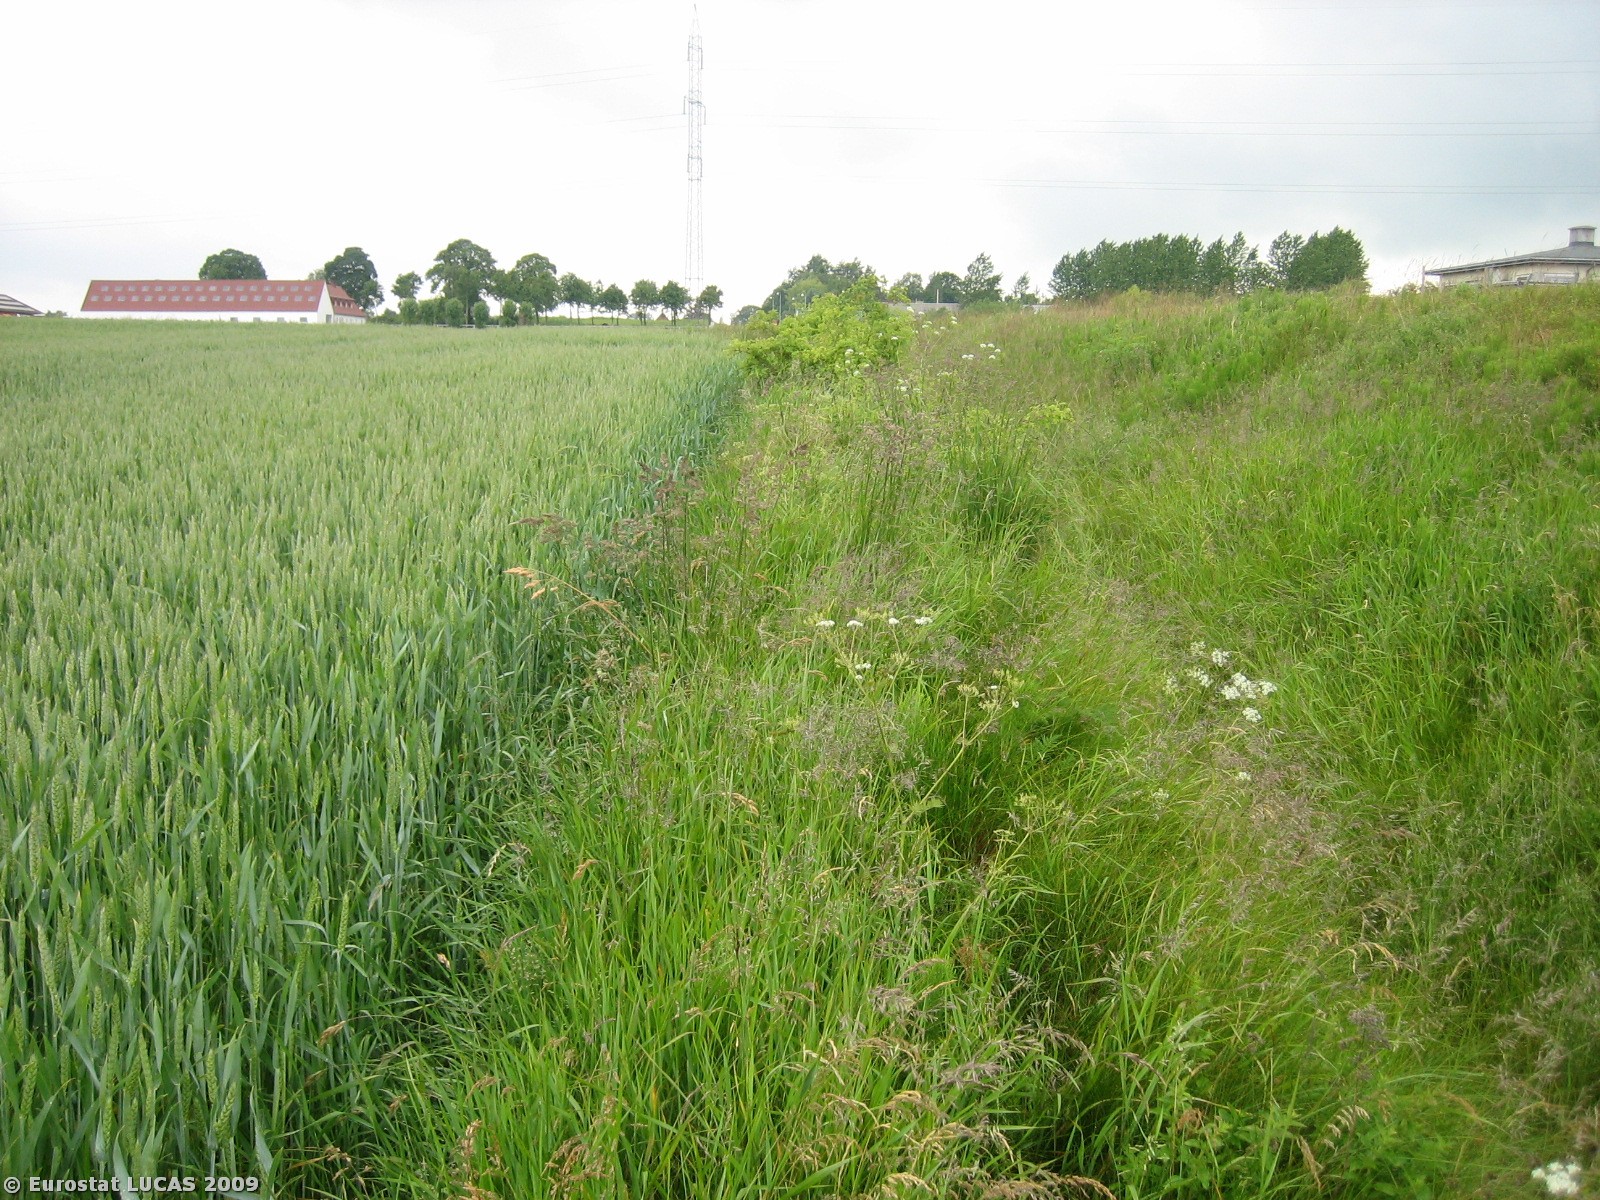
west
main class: Cropland
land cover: Common wheat
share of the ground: > 75 %
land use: Agriculture (excluding fallow land and kitchen gardens)
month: June
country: DK
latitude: 56.1518
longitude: 10.0161
